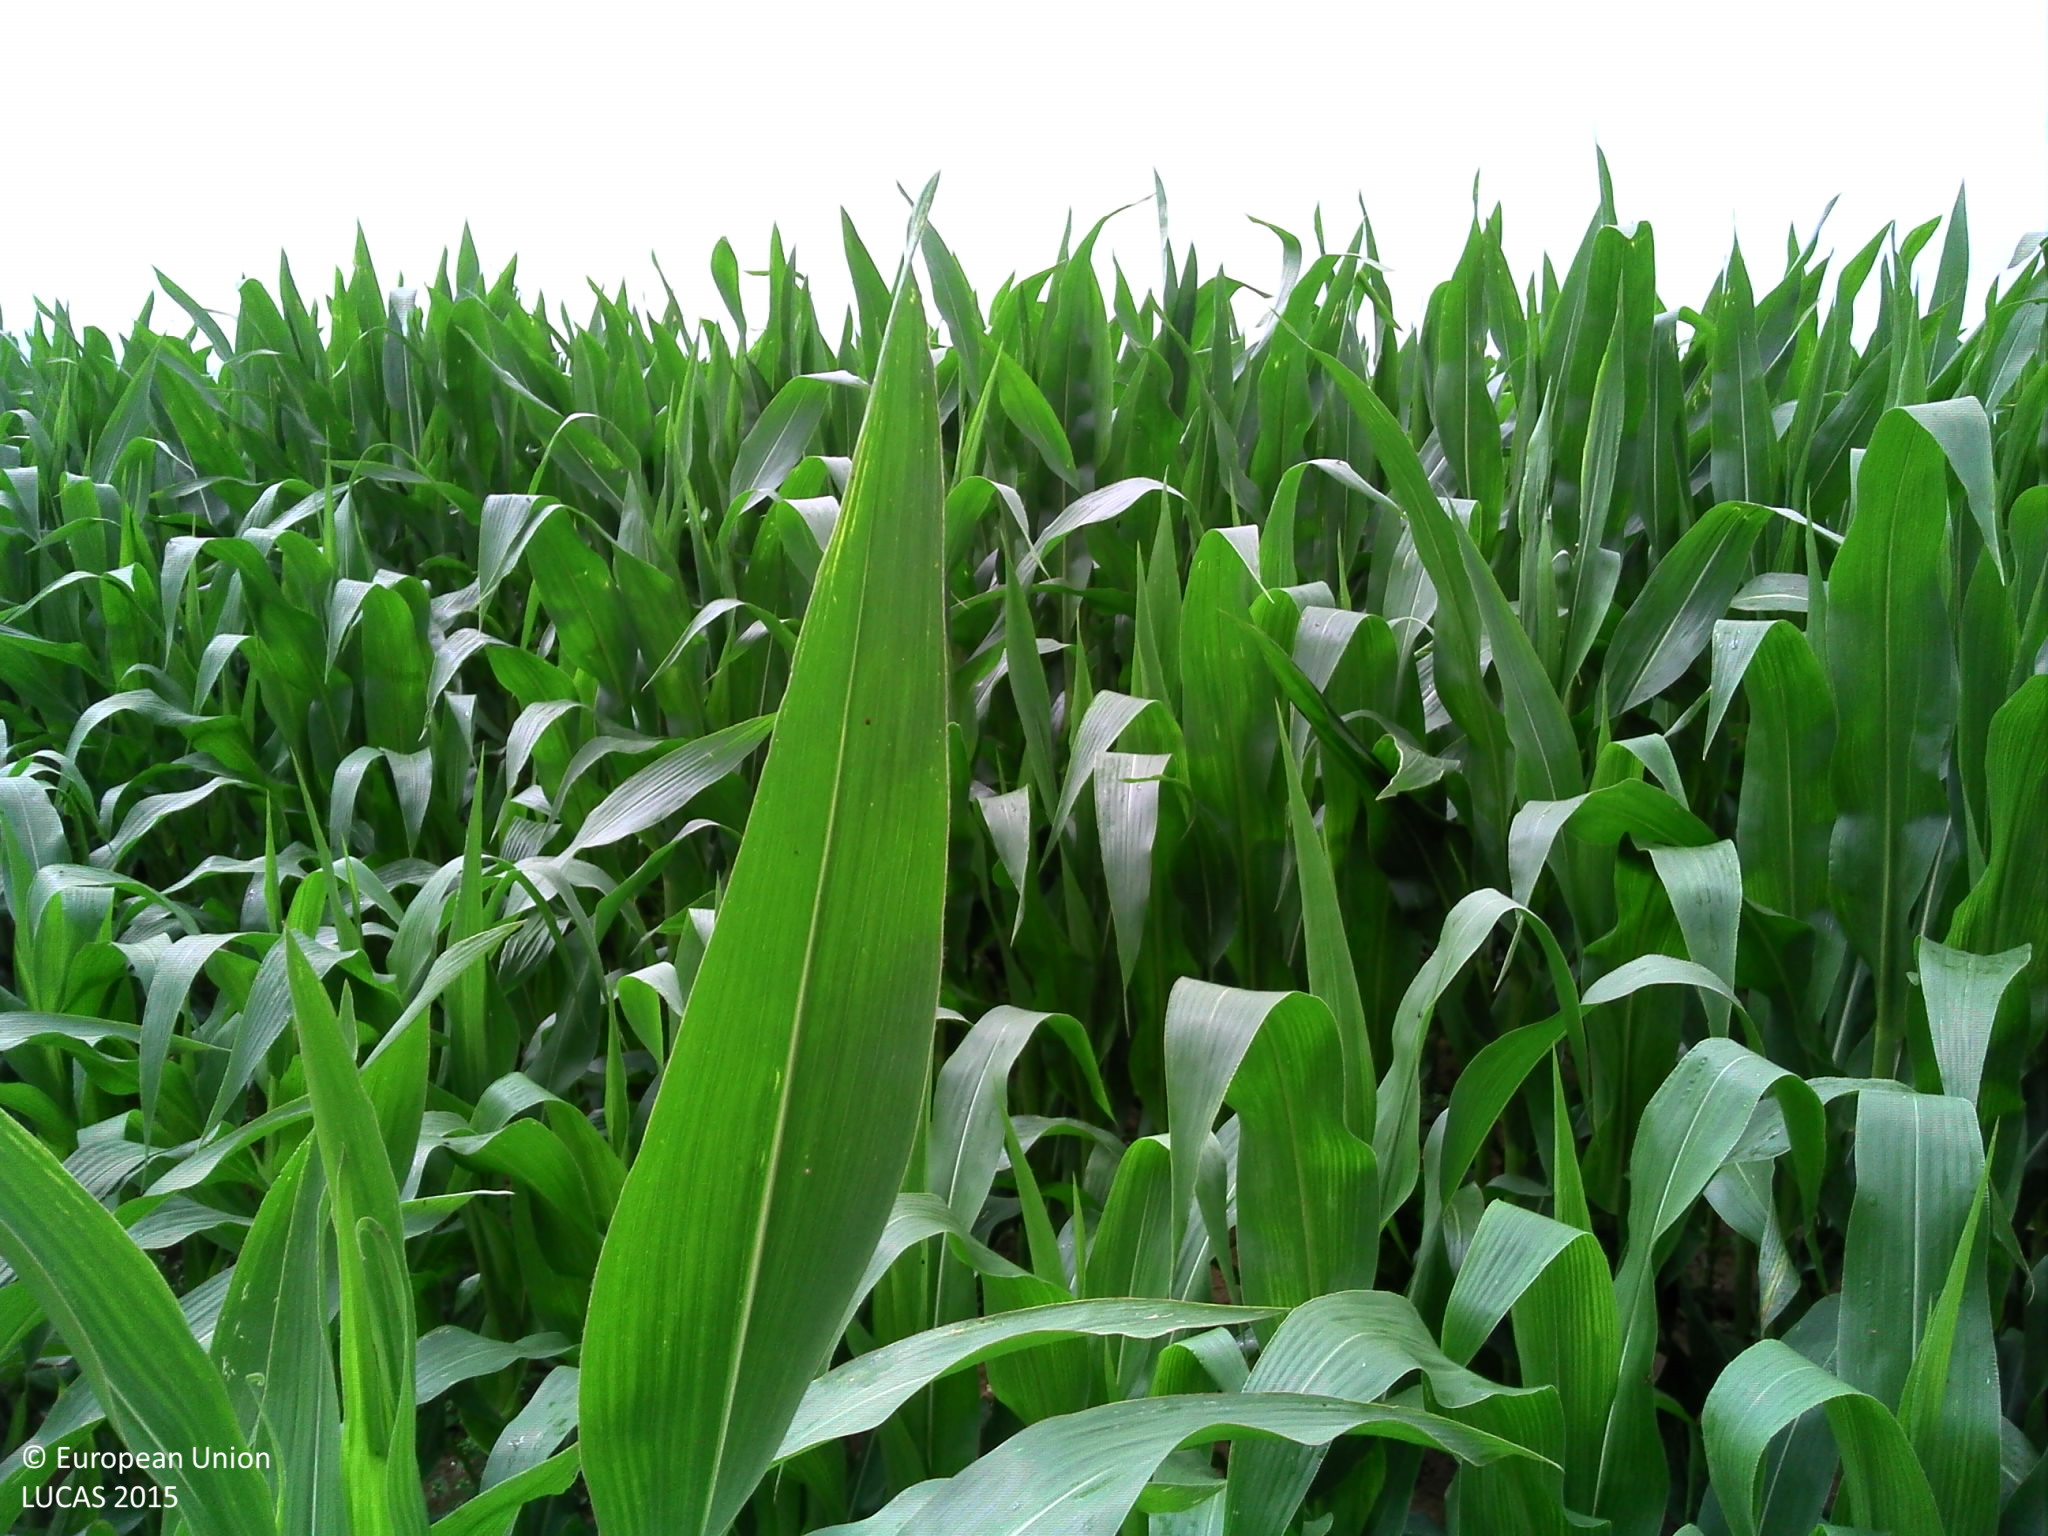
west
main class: Cropland
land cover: Maize
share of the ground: > 75 %
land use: Agriculture (excluding fallow land and kitchen gardens)
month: July
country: FR
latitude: 50.1198
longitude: 2.5332
